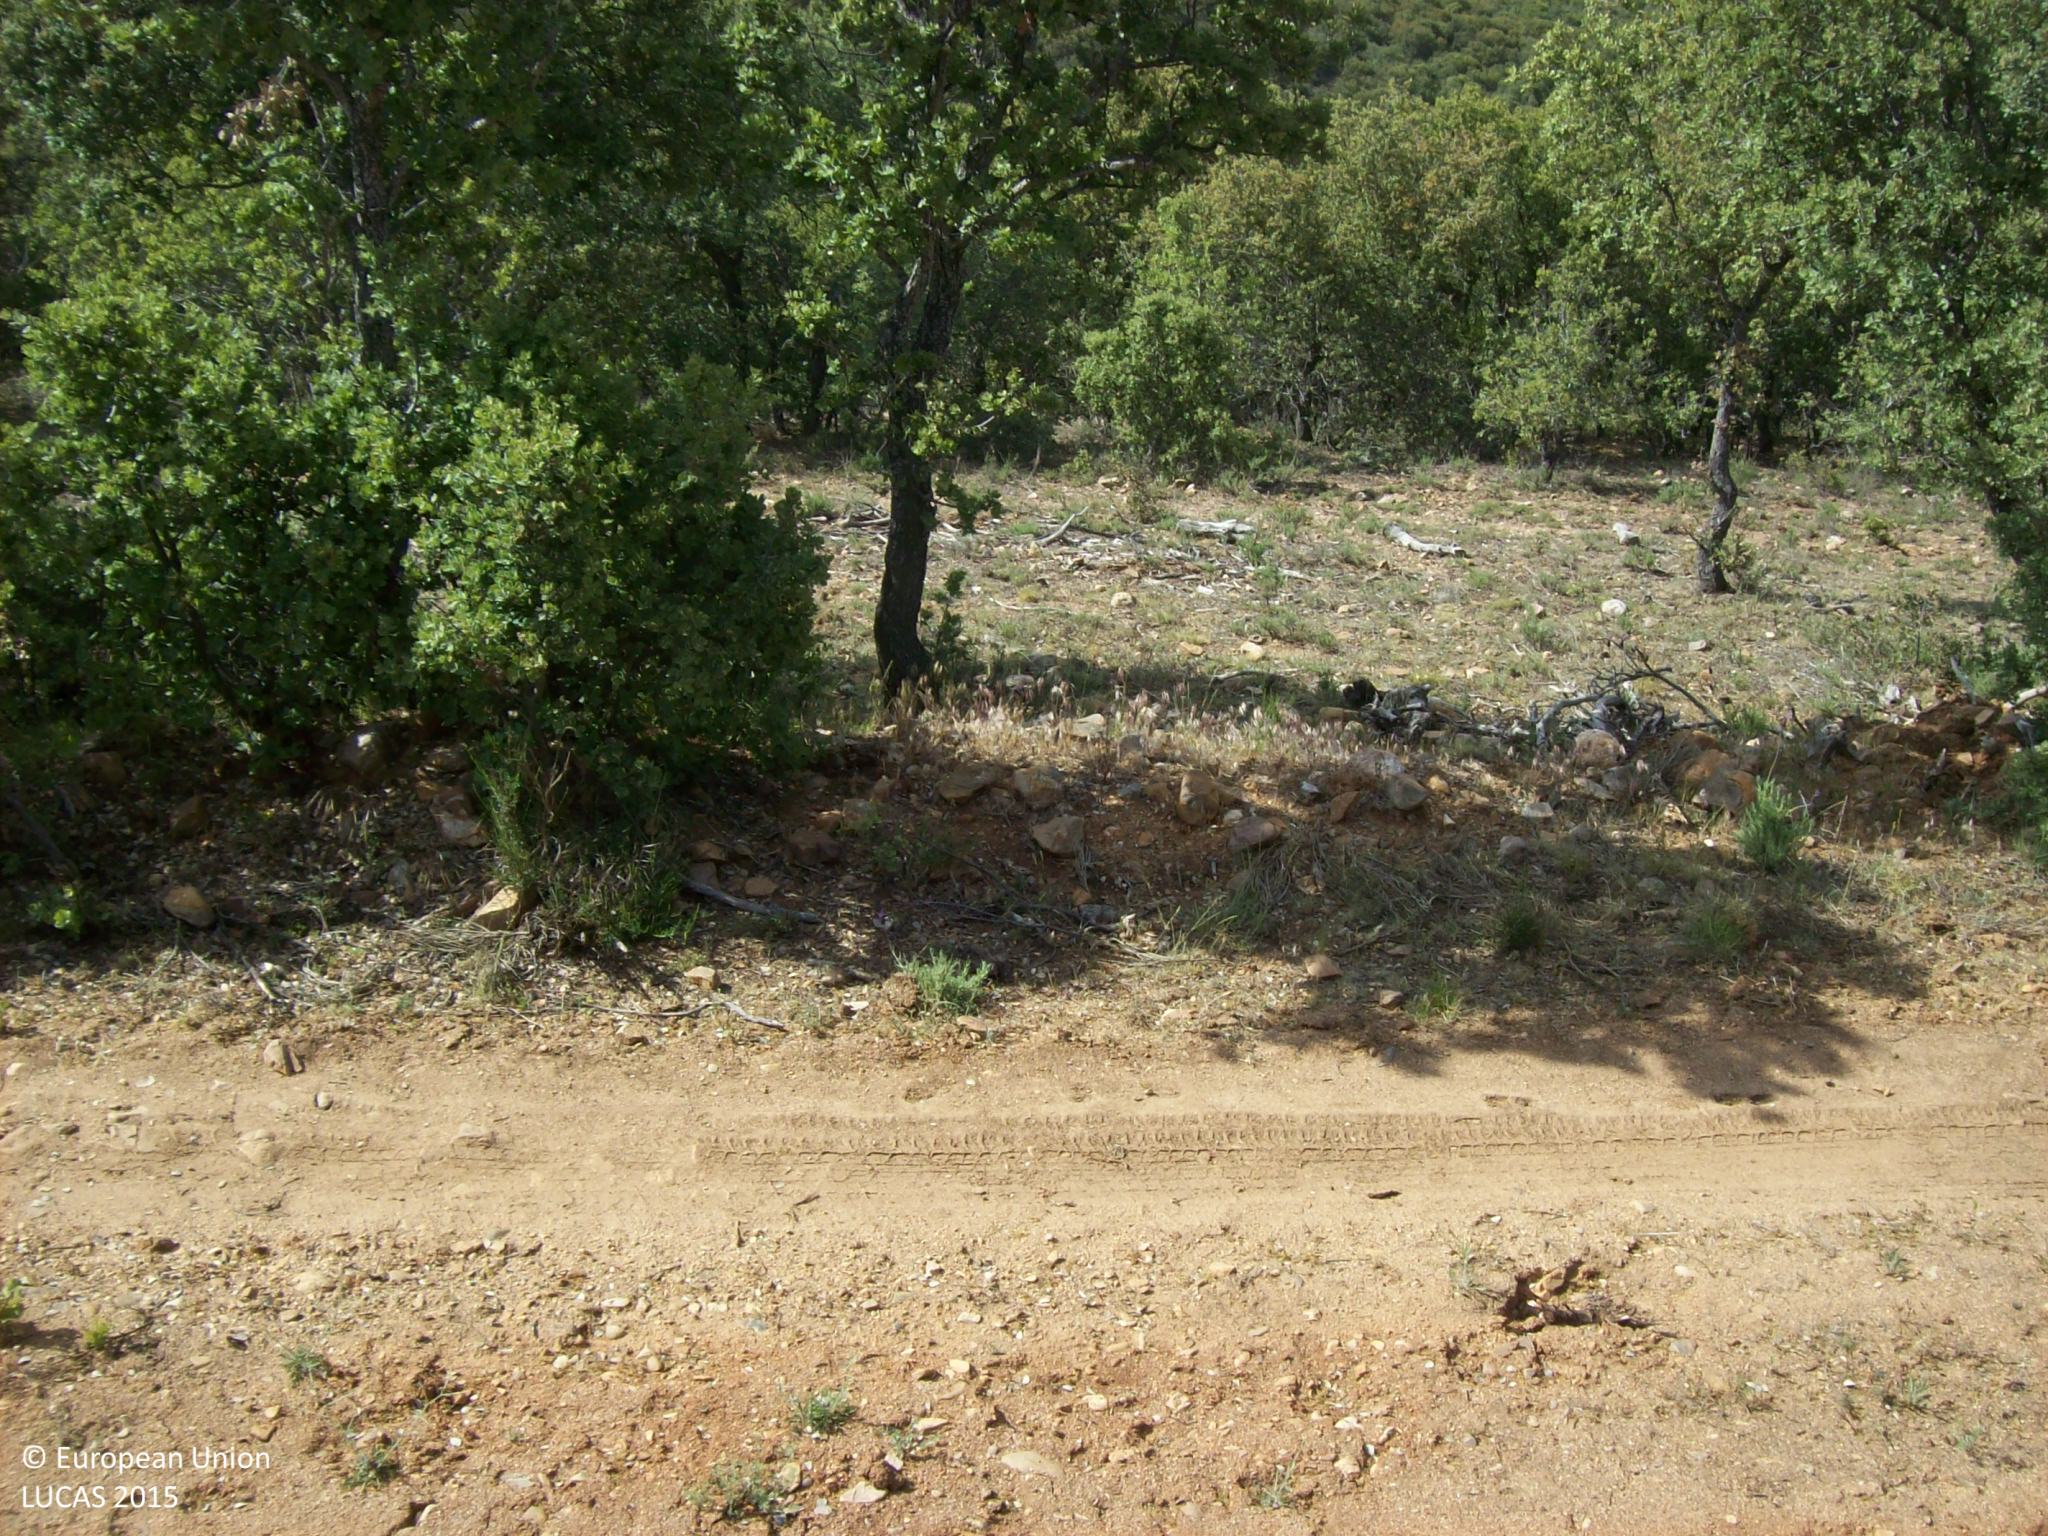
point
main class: Woodland
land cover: Broadleaved woodland
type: broadleaved evergreen forest
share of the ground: 50 - 75 %
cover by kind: broadleaved forest trees 60 %, herbaceous plants 15 %, shrubs 10 %, unconsolidated bare surface 10 %, lichens and mosses 5 %
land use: Forestry
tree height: > 5 m
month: May
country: ES
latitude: 40.8685
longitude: -4.5188
